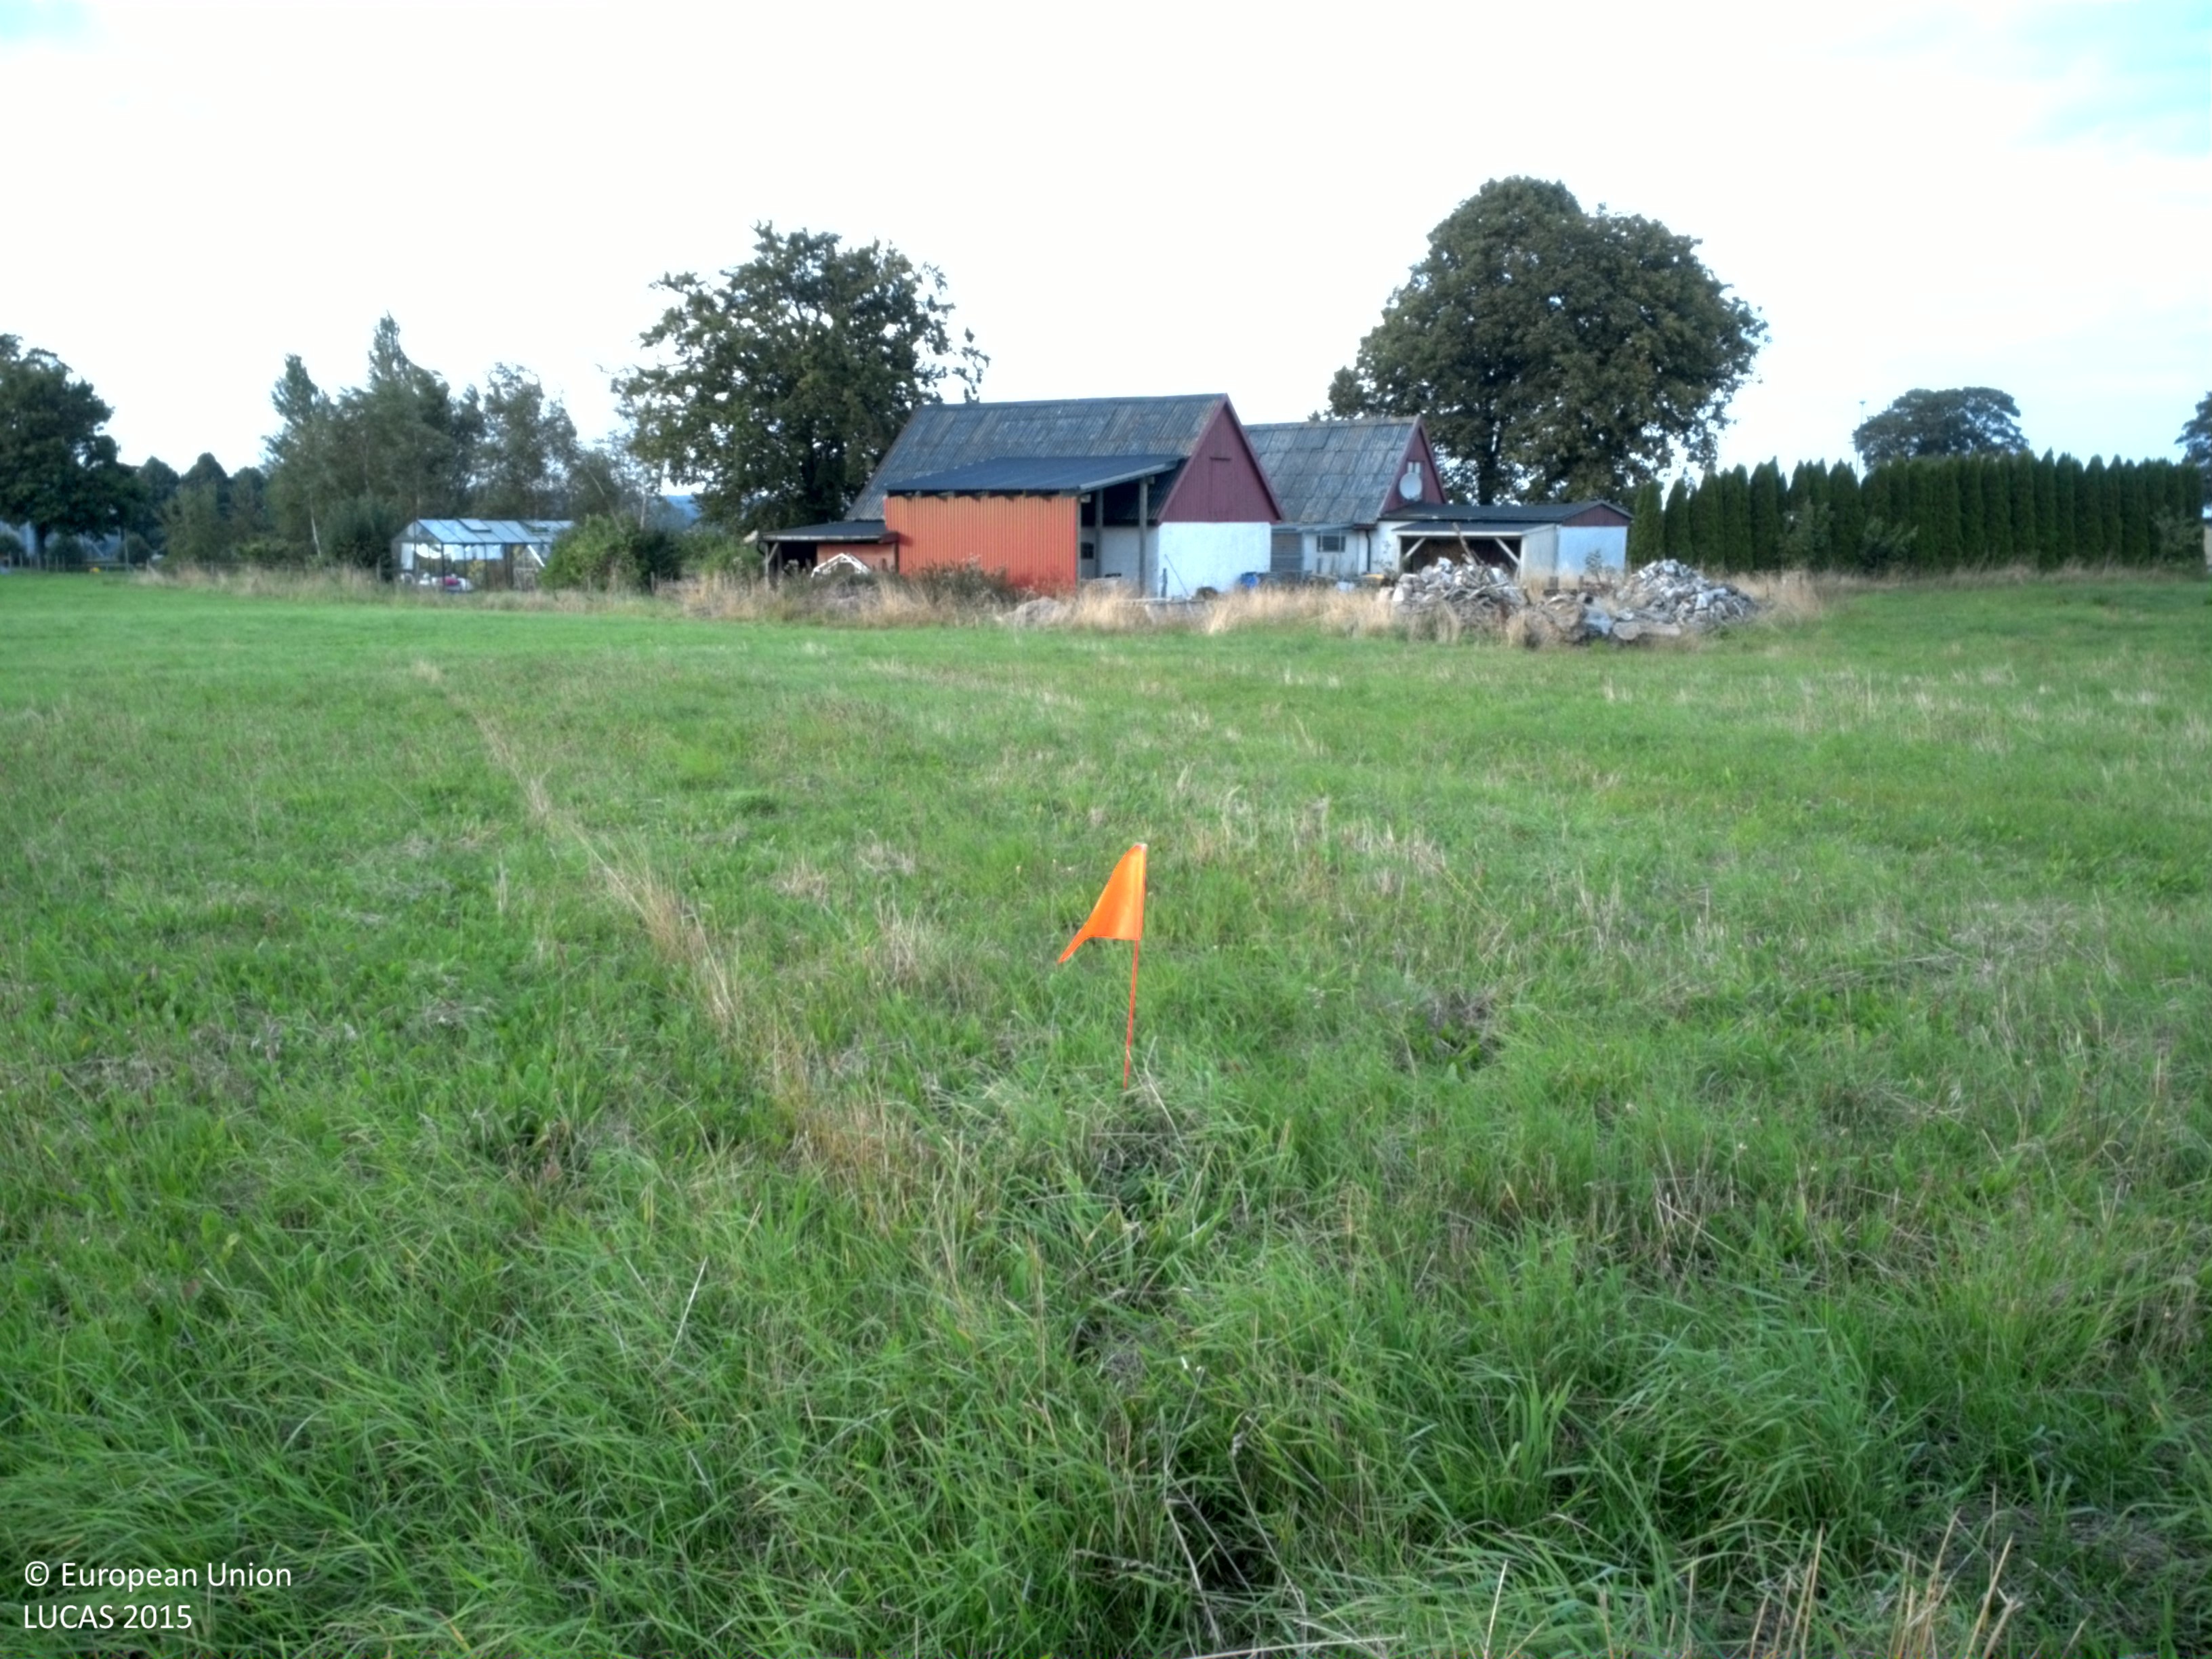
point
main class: Grassland
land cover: Grassland without tree/shrub cover
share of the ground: > 75 %
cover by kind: herbaceous plants 100 %
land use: Agriculture (excluding fallow land and kitchen gardens)
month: August
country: SE
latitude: 55.4521
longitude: 13.6508
